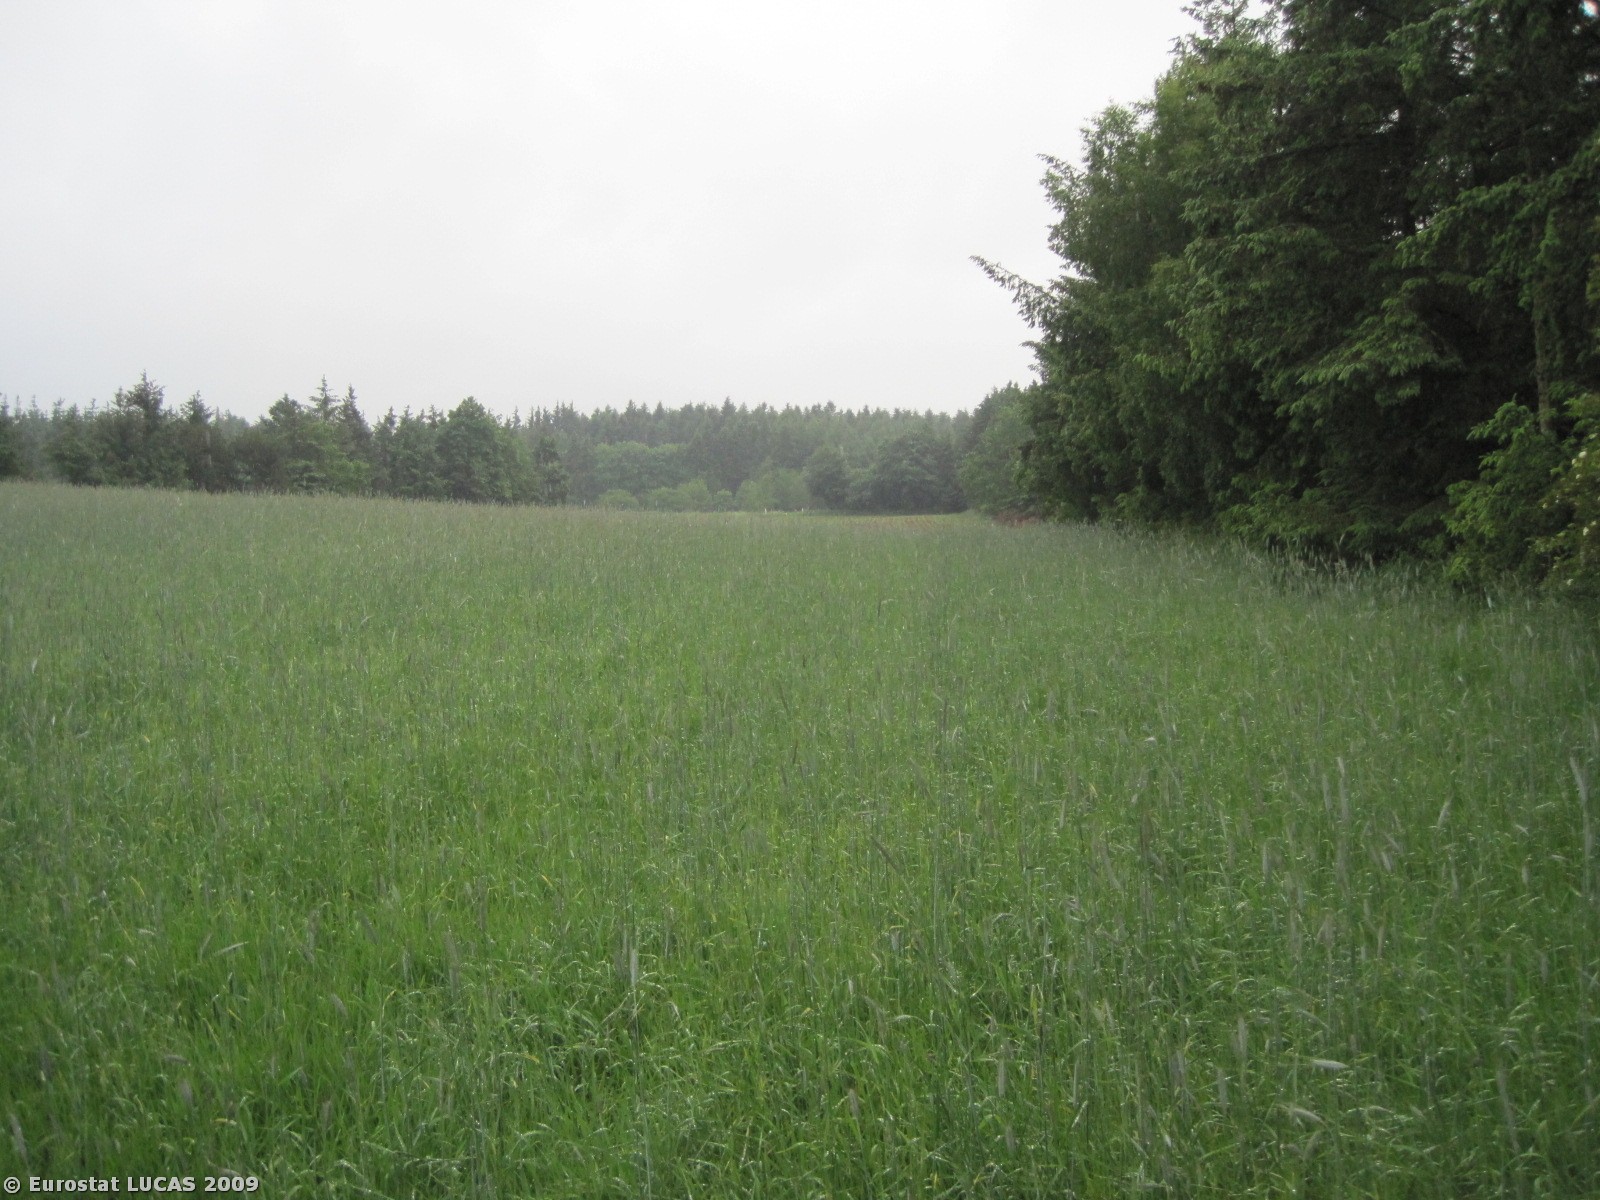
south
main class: Grassland
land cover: Grassland without tree/shrub cover
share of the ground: > 75 %
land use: Agriculture (excluding fallow land and kitchen gardens)
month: June
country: DK
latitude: 57.4641
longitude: 10.1498
